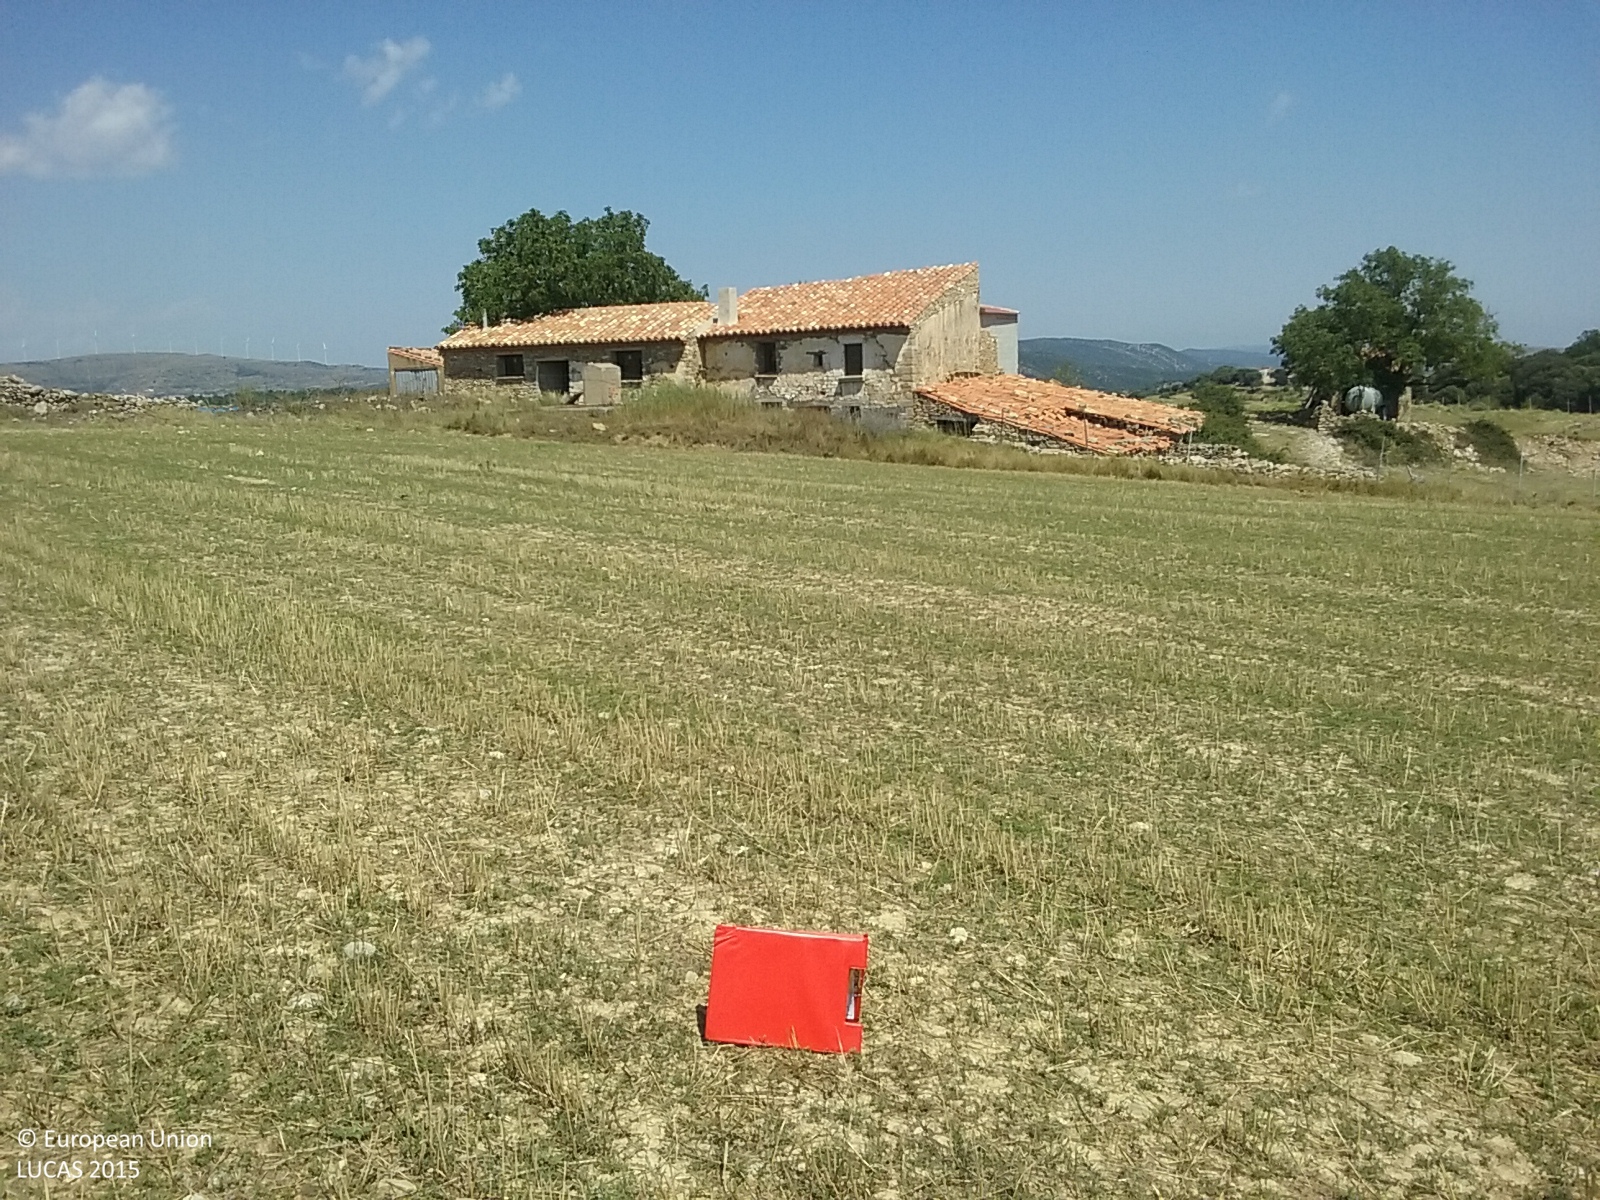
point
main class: Cropland
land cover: Barley
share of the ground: < 10 %
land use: Agriculture (excluding fallow land and kitchen gardens)
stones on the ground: < 10 %
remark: Harvested field
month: August
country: ES
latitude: 40.4982
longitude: -0.2133
